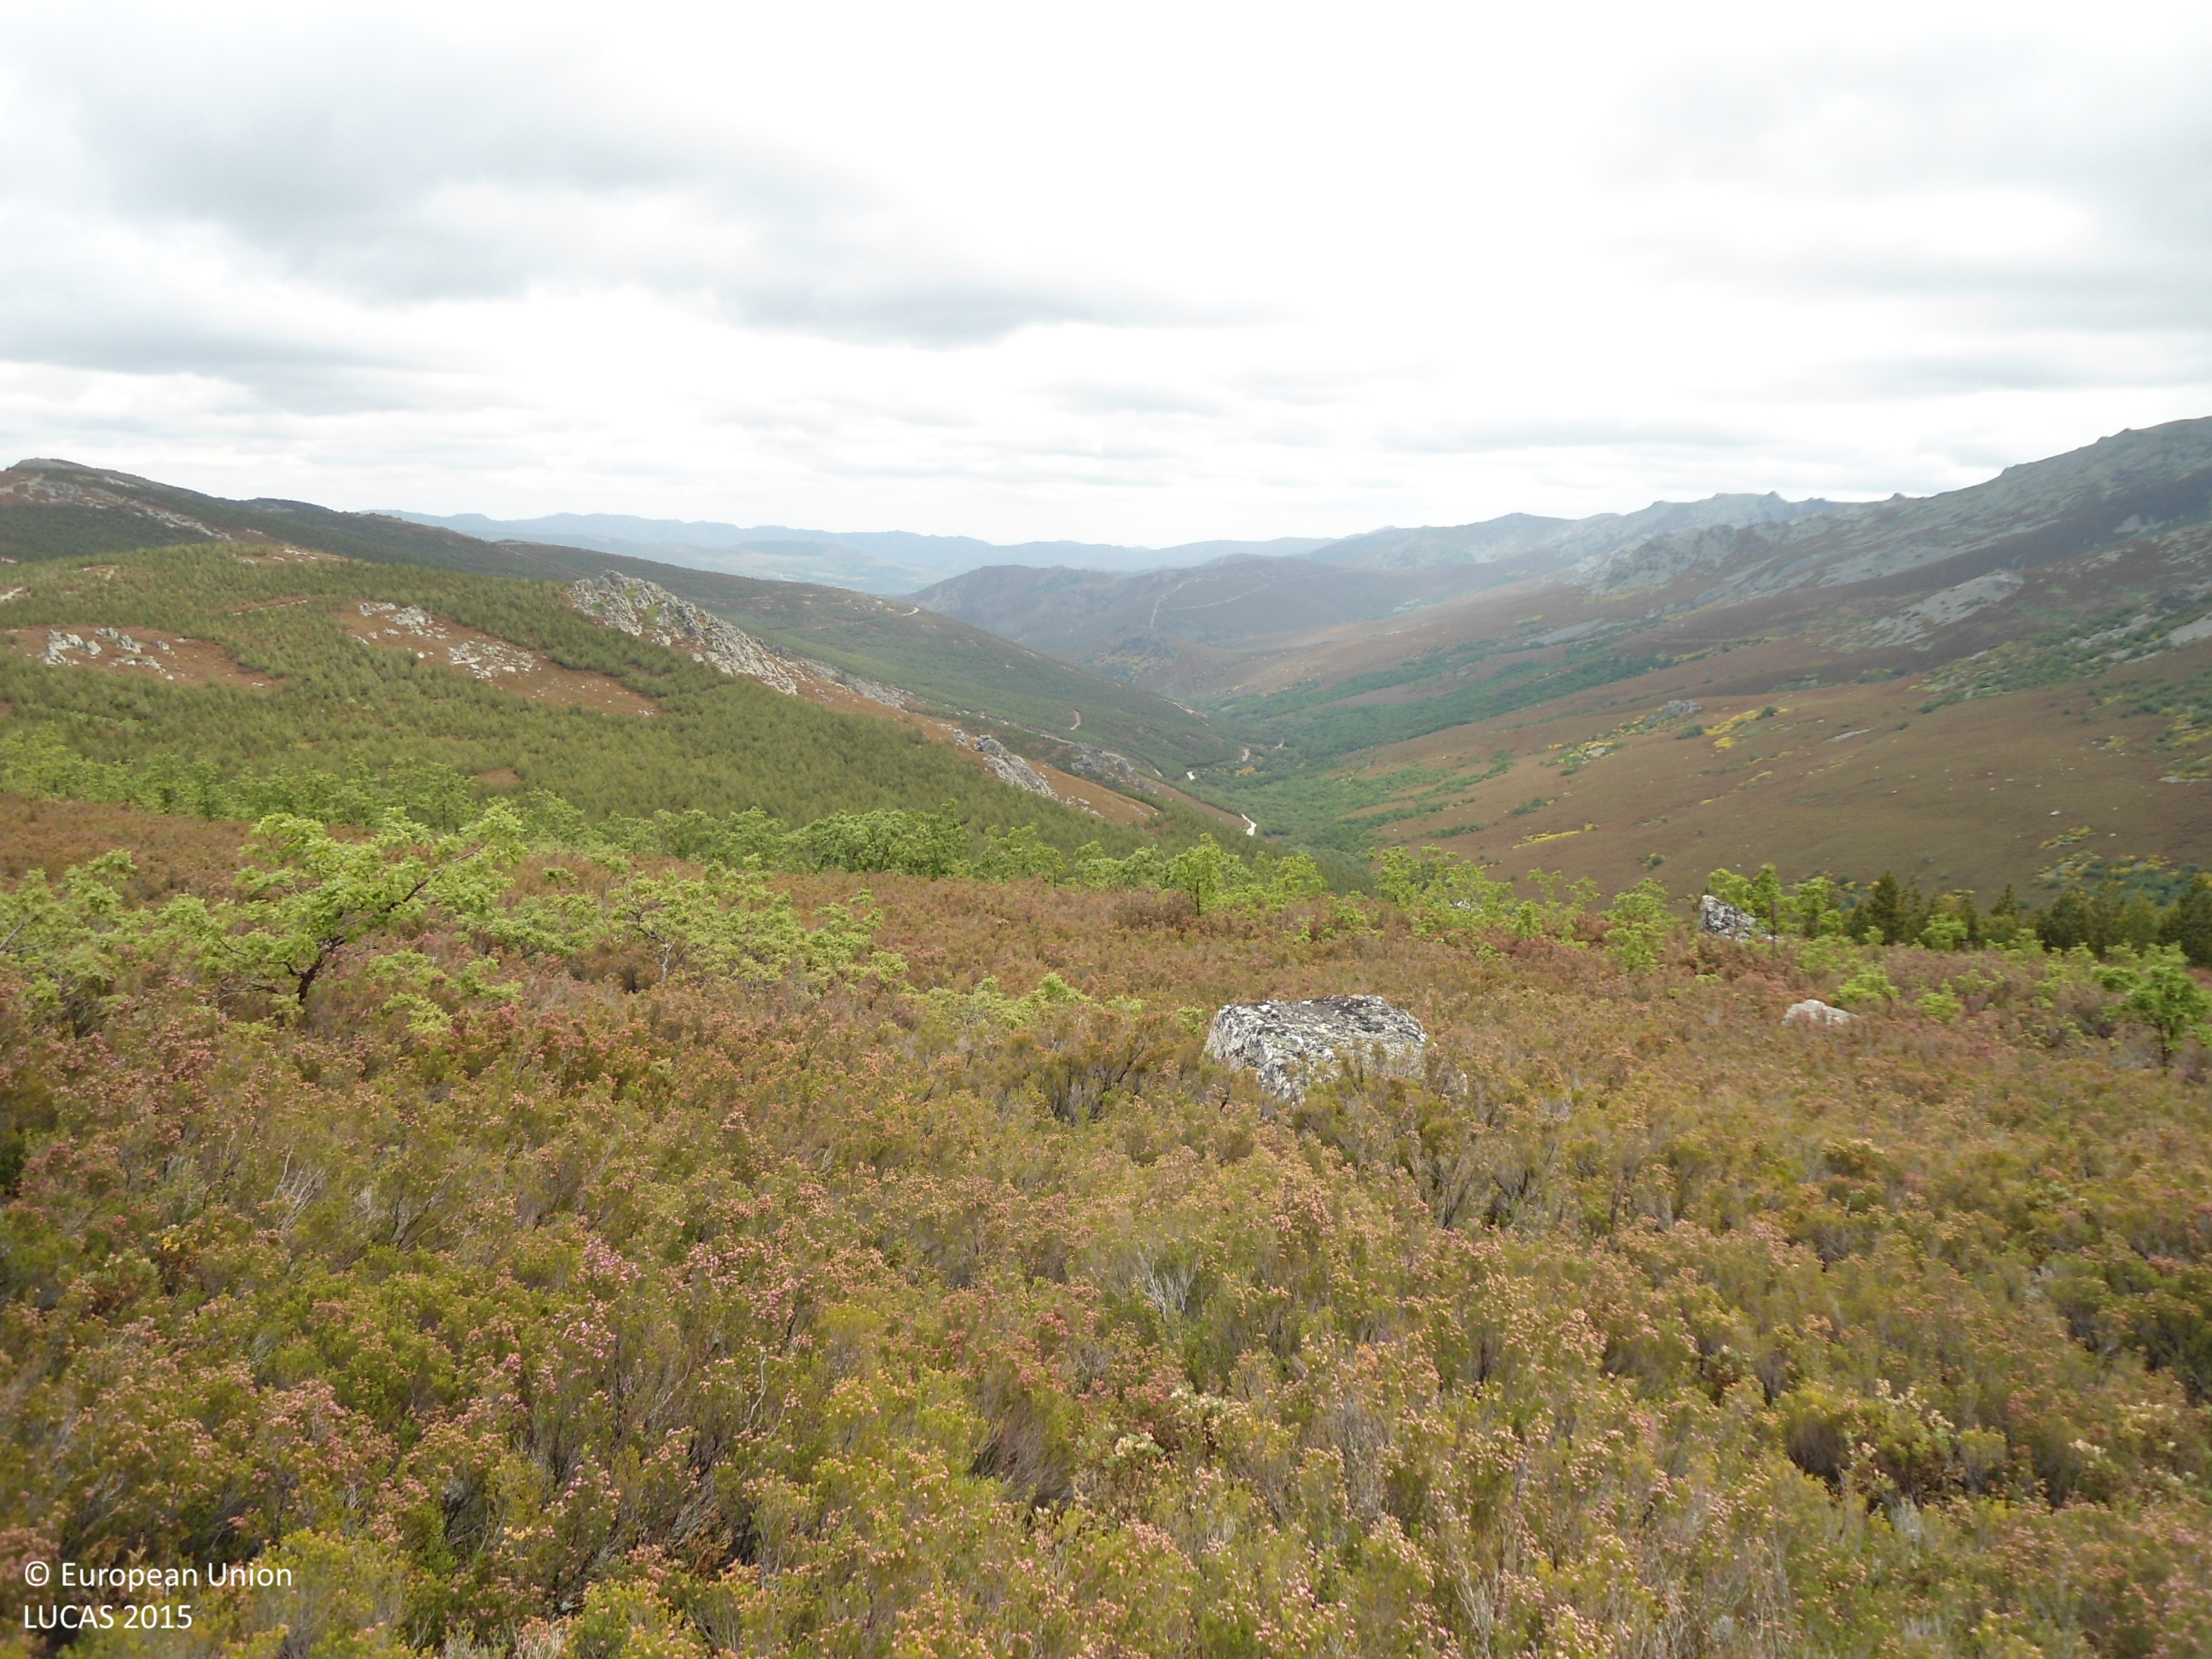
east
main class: Shrubland
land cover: Shrubland with sparse tree cover
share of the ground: > 75 %
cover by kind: shrubs 90 %, broadleaved forest trees 5 %, unconsolidated bare surface 5 %
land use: Semi-natural and natural areas not in use
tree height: < 5 m
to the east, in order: Shrubland with sparse tree cover; Tracks; Shrubland with sparse tree cover; Rocks and stones; Rock outcrops; Rocks and stones
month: June
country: ES
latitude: 42.2191
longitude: -6.5534
